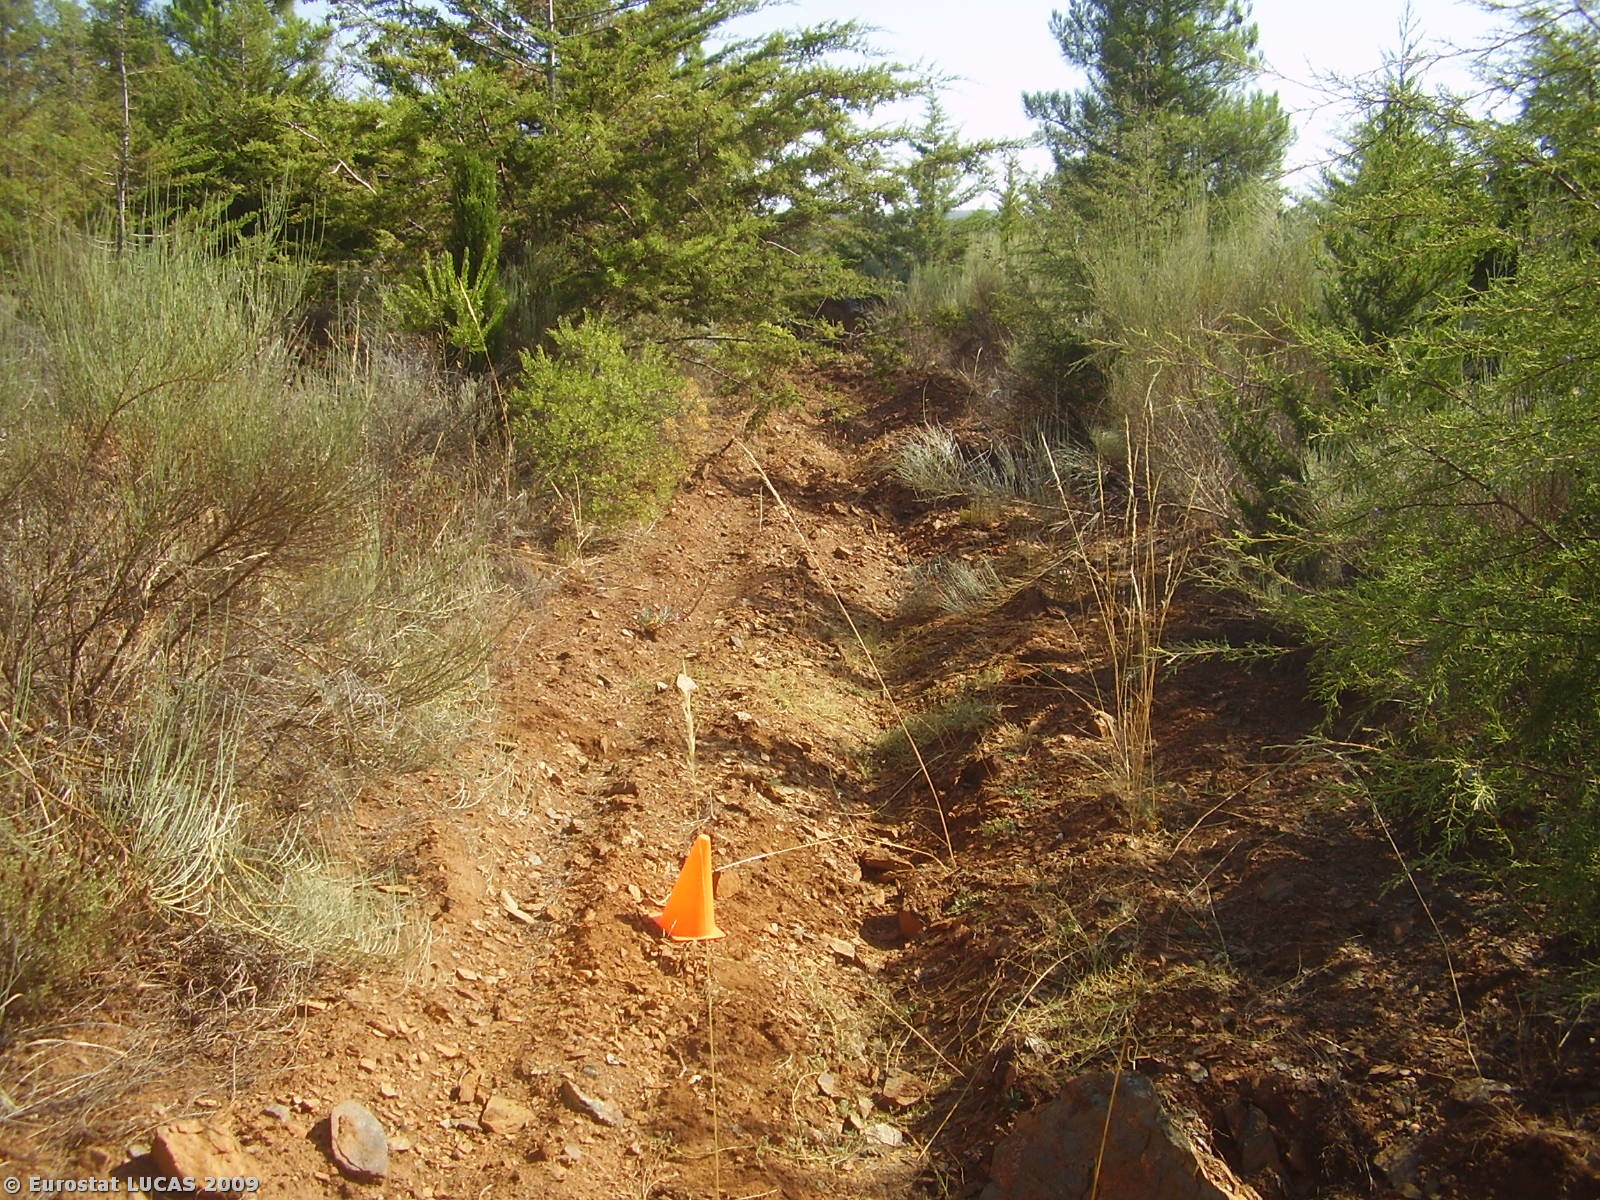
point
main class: Woodland
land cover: Coniferous woodland
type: coniferous forest of the mediterranean region
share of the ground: 25 - 50 %
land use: Forestry
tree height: > 5 m
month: August
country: PT
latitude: 41.4853
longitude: -6.8666
